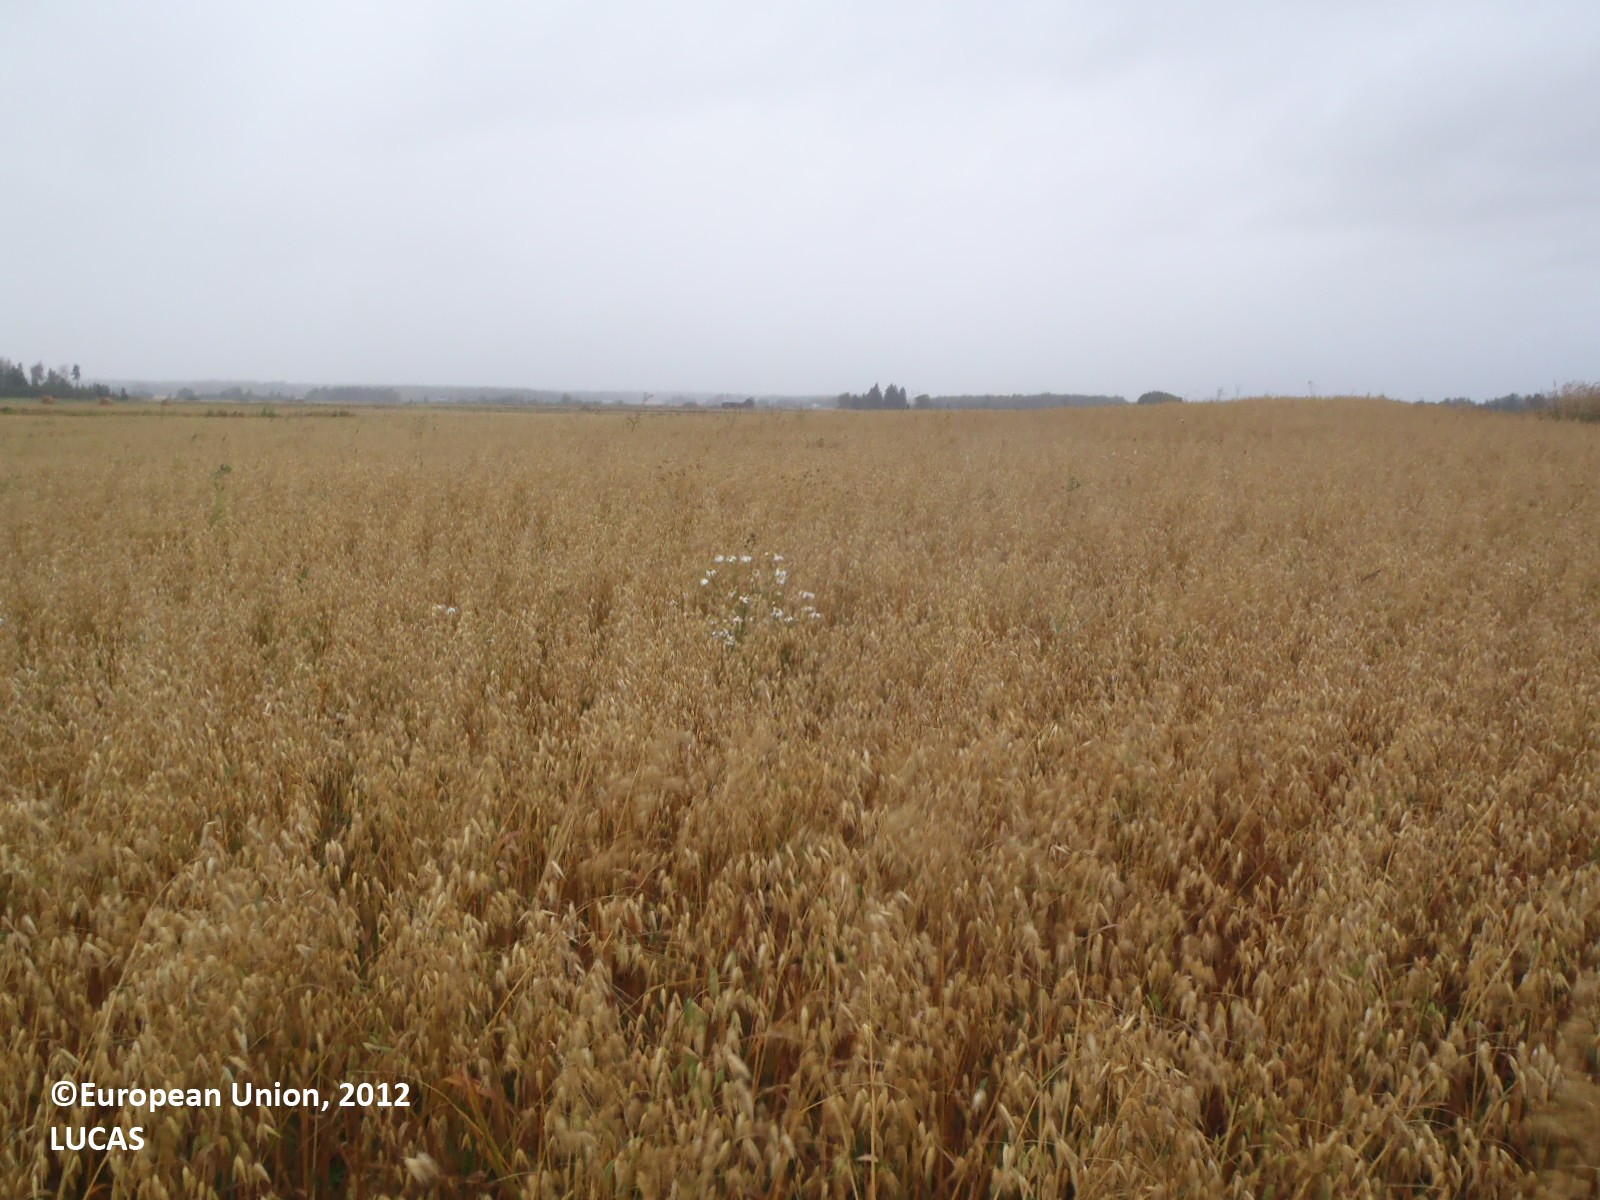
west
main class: Cropland
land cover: Oats
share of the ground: > 75 %
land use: Agriculture (excluding fallow land and kitchen gardens)
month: September
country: FI
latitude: 61.2499
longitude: 22.6855
